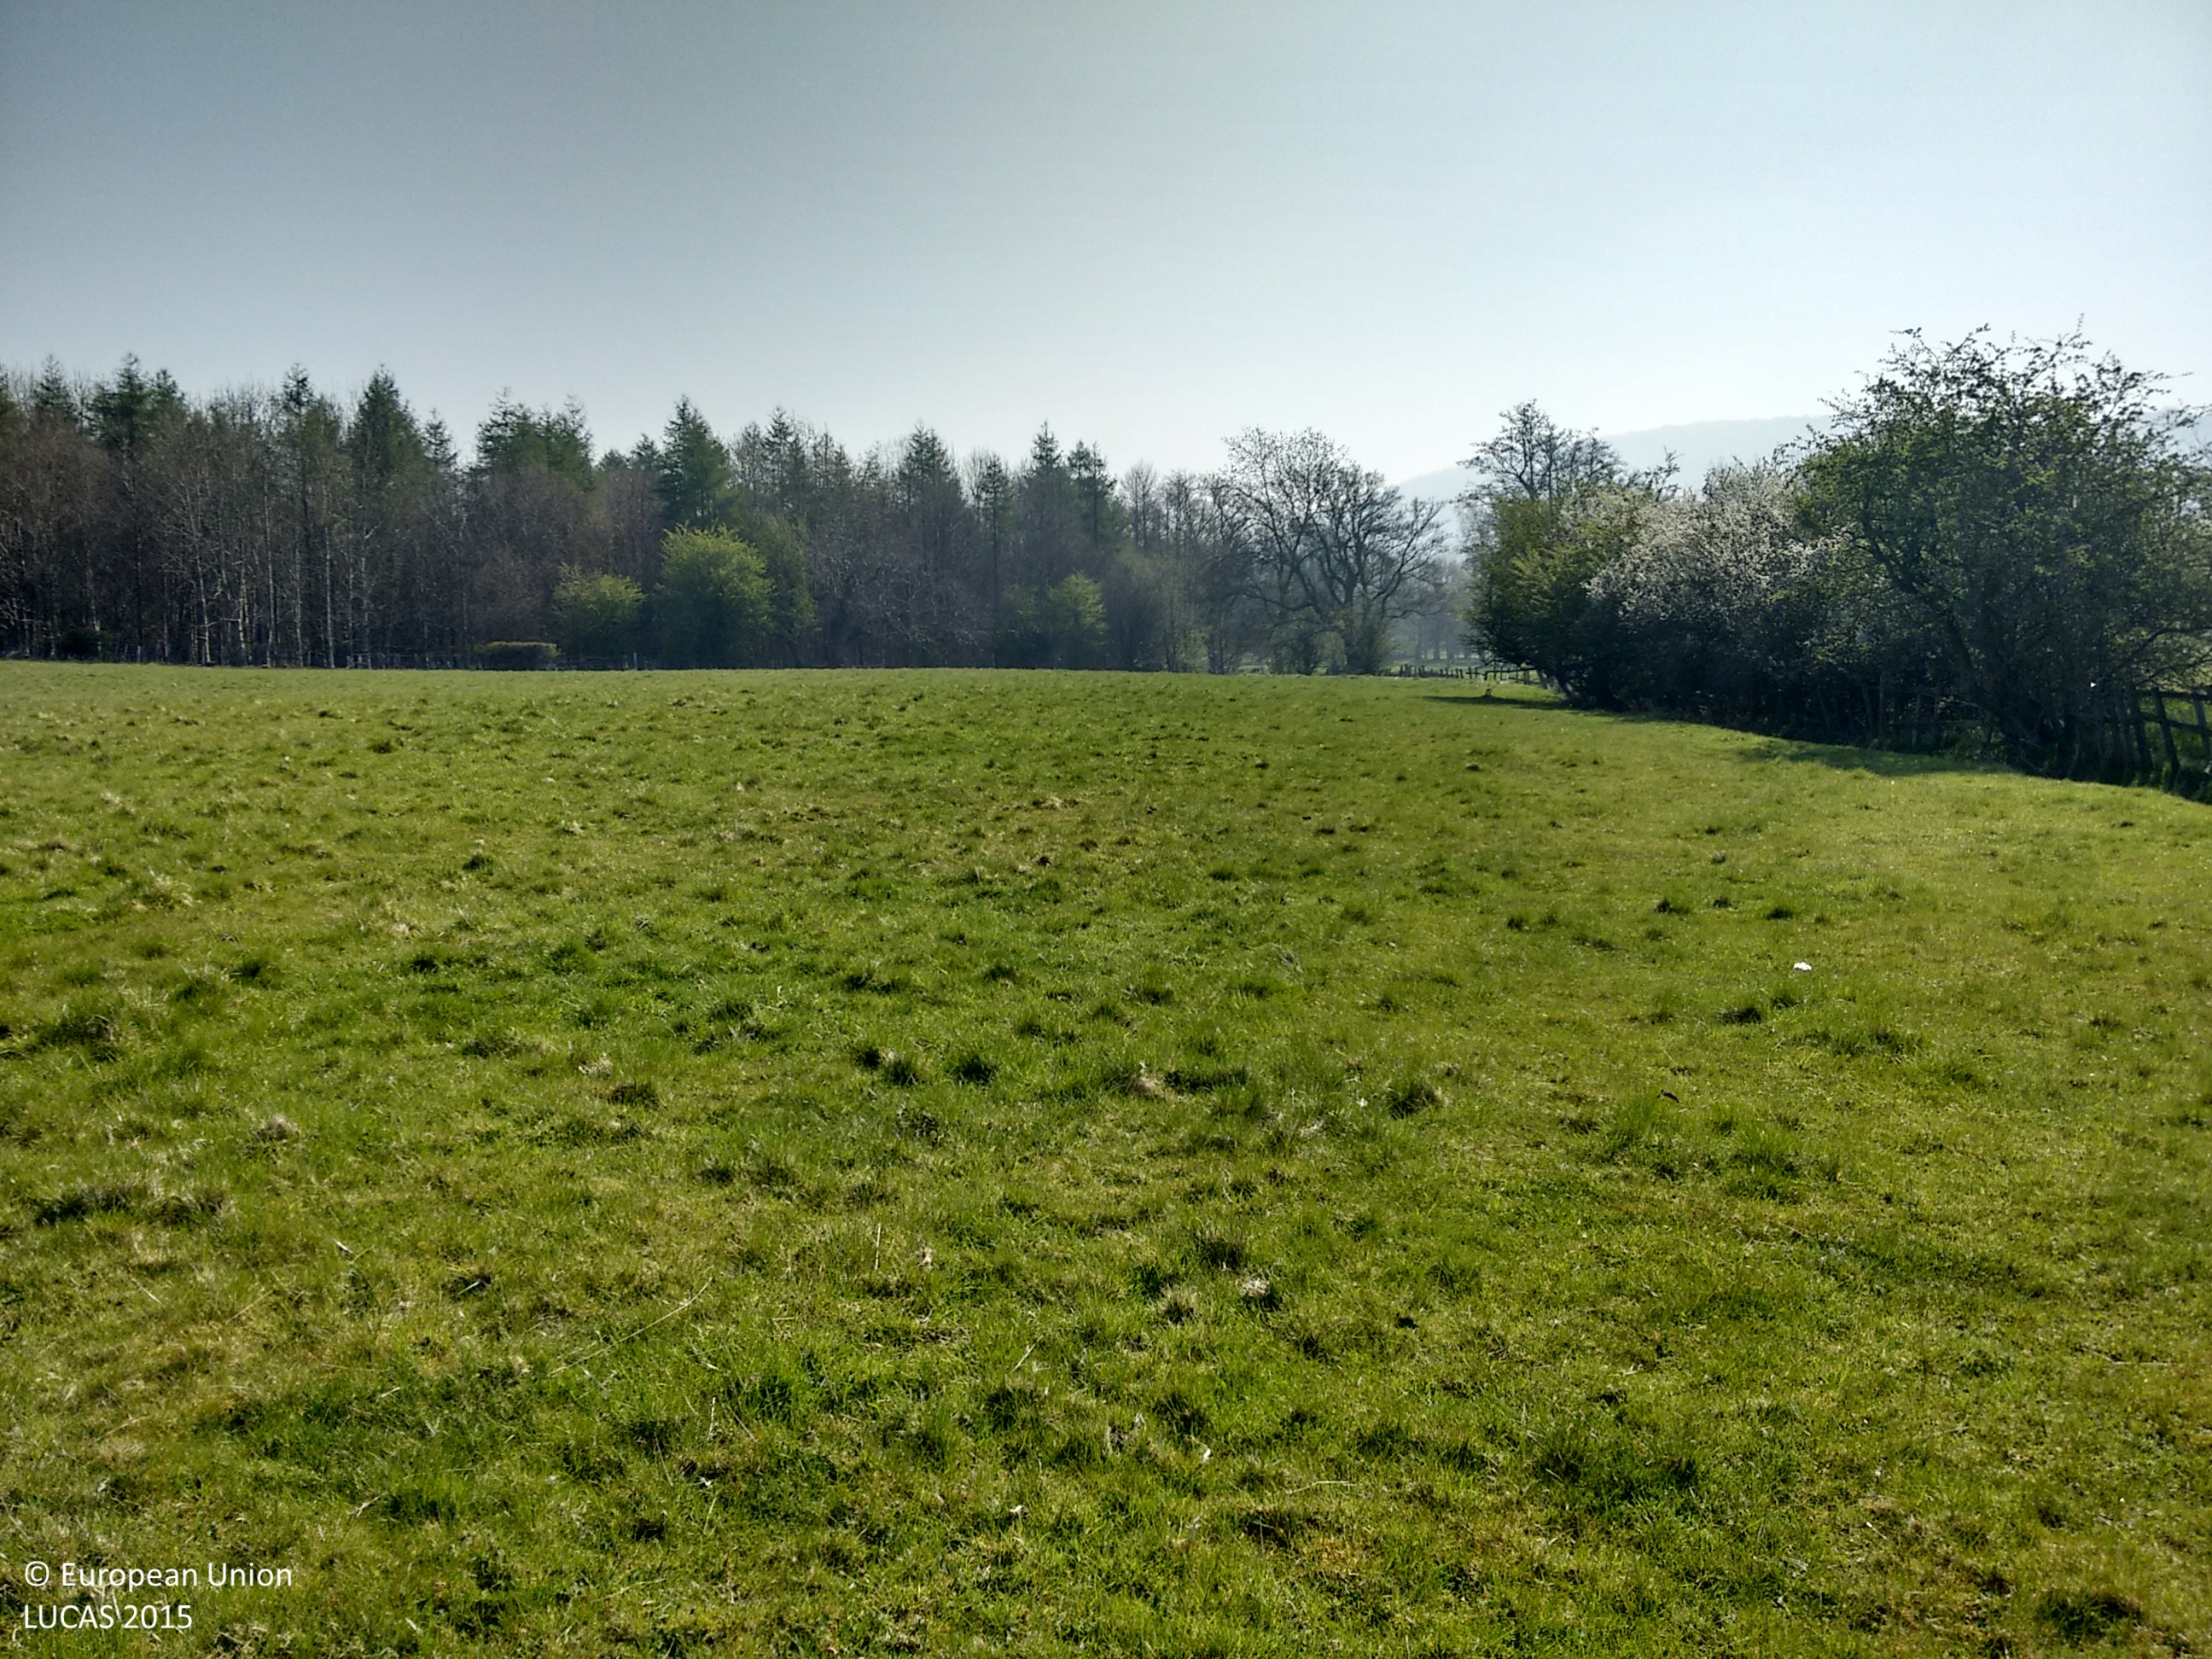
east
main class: Grassland
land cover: Grassland without tree/shrub cover
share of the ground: > 75 %
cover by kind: herbaceous plants 100 %
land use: Agriculture (excluding fallow land and kitchen gardens)
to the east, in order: Grassland without tree/shrub cover; Fences; Spruce dominated mixed woodland; Fences; Rivers and streams; Broadleaved woodland
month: April
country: GB
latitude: 53.9023
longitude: -1.7265
